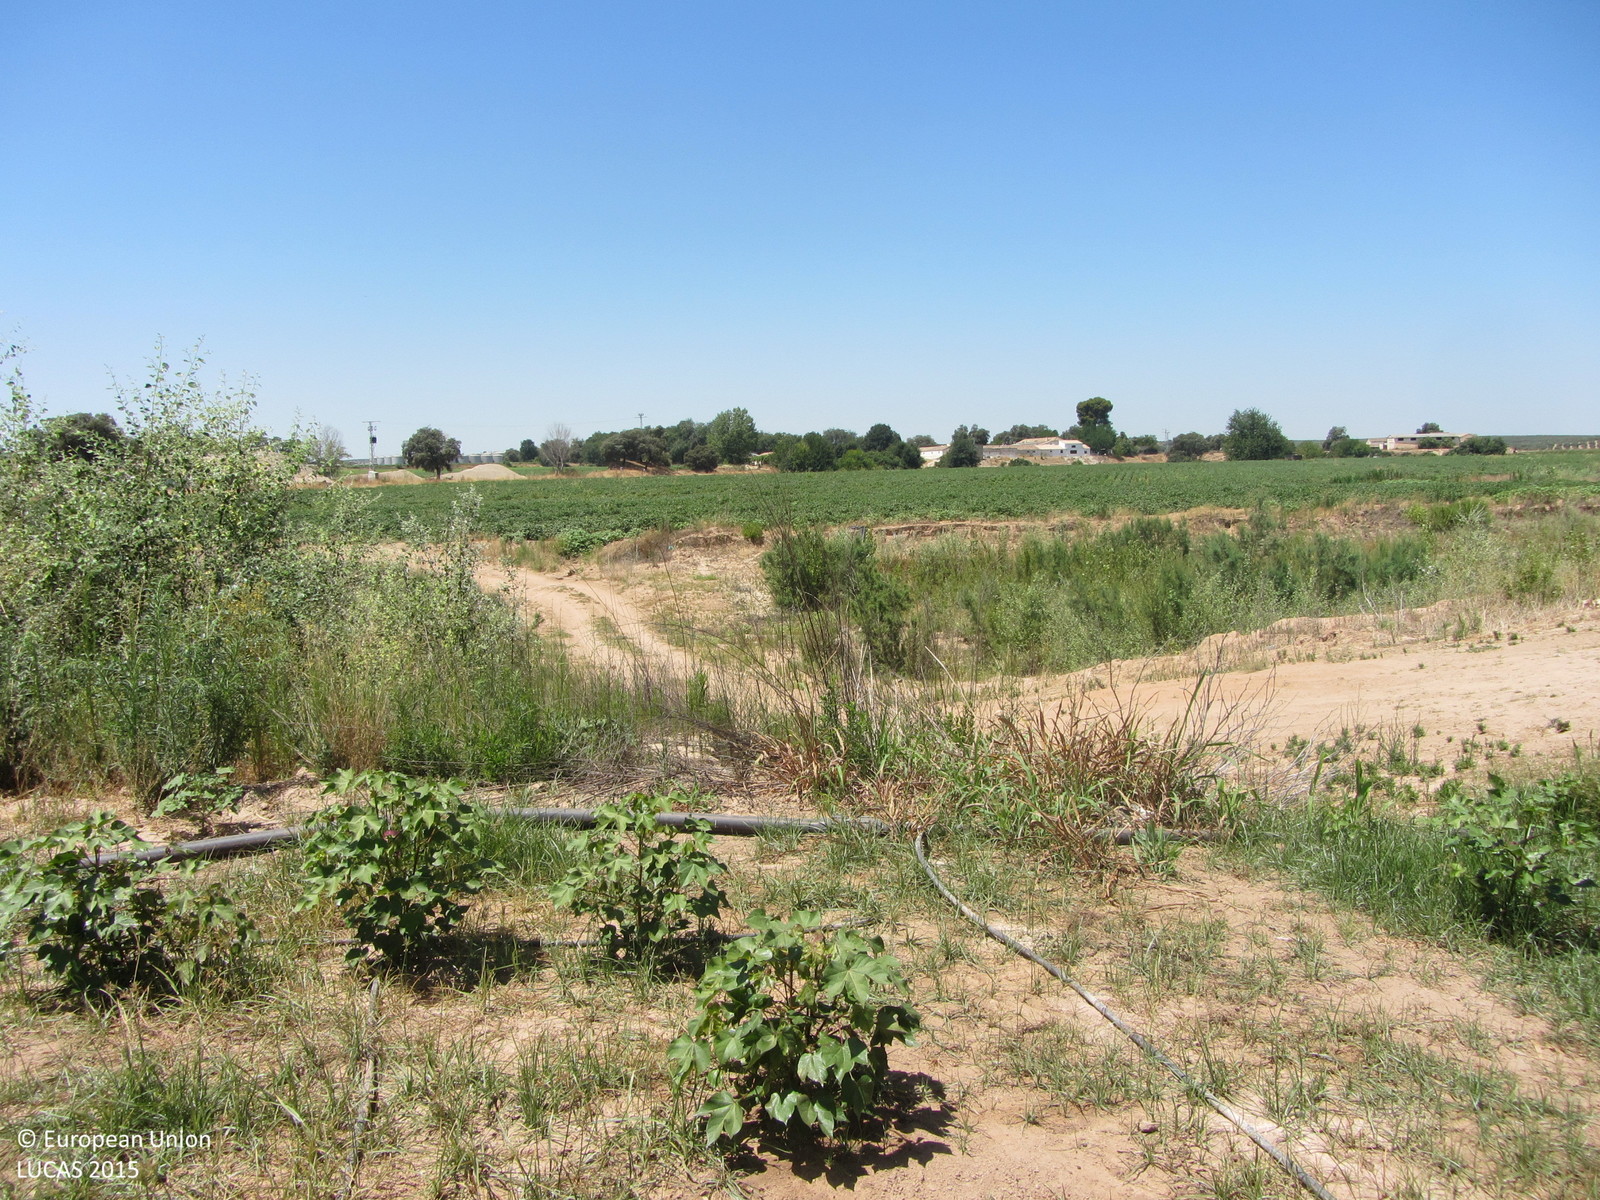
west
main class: Cropland
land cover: Cotton
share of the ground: > 75 %
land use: Agriculture (excluding fallow land and kitchen gardens)
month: July
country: ES
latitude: 38.0183
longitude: -3.8218
